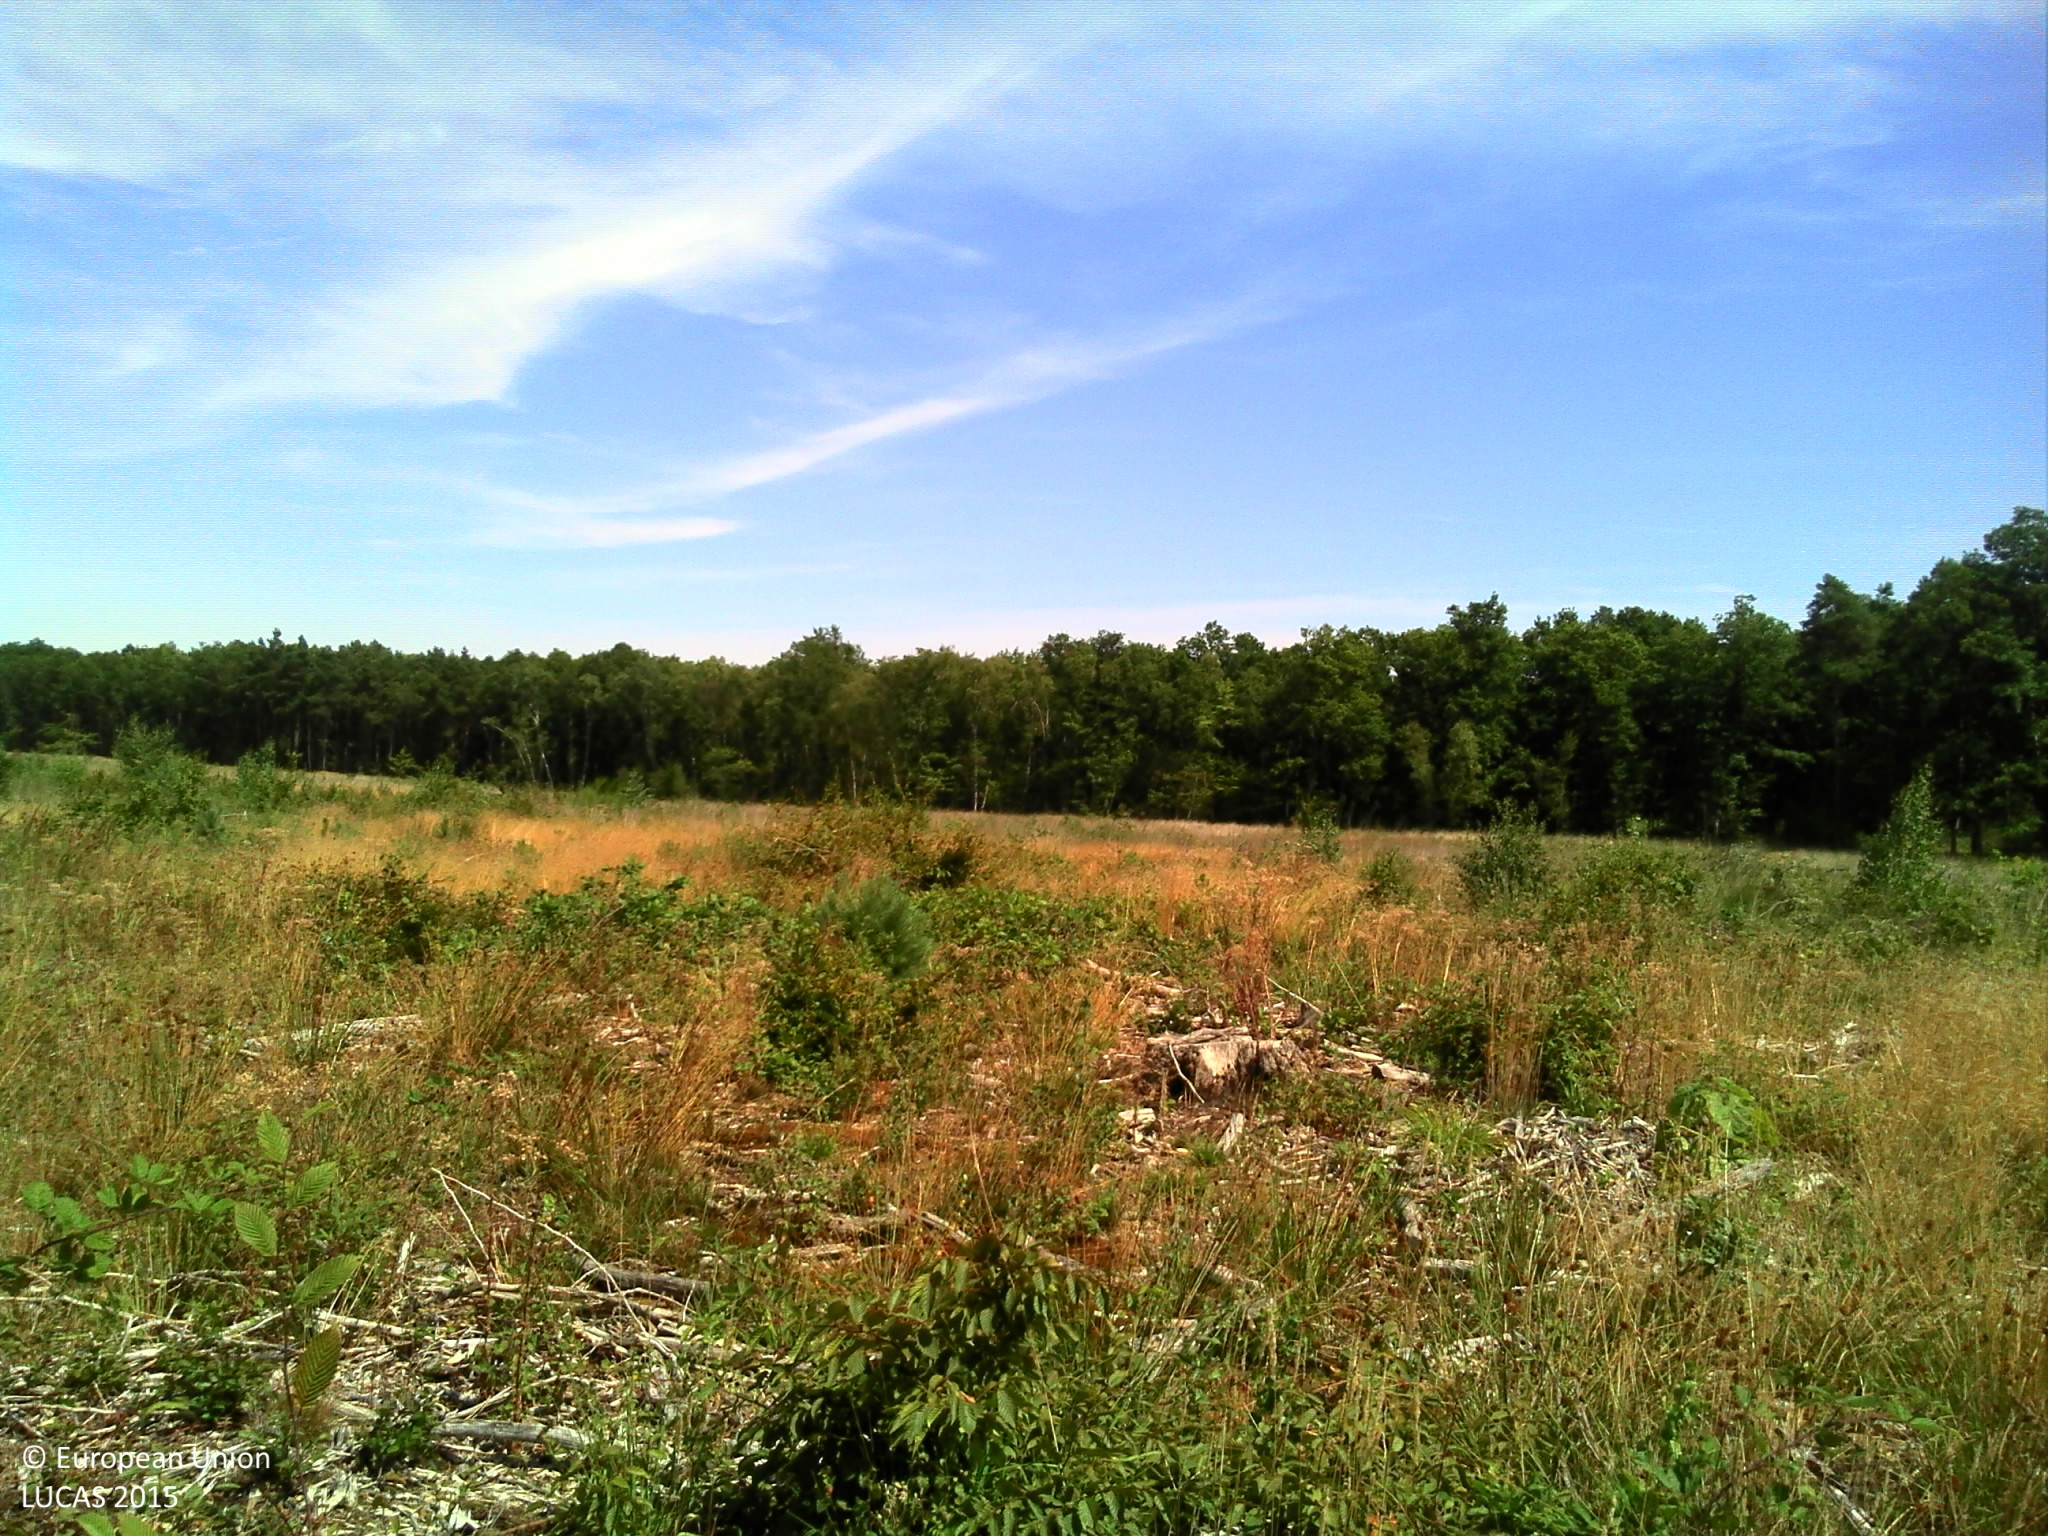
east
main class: Shrubland
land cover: Shrubland with sparse tree cover
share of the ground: > 75 %
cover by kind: herbaceous plants 85 %, shrubs 10 %, broadleaved forest trees 5 %
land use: Forestry
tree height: < 5 m
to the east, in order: Shrubland with sparse tree cover; Broadleaved woodland
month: July
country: FR
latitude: 47.9482
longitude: 1.9675
